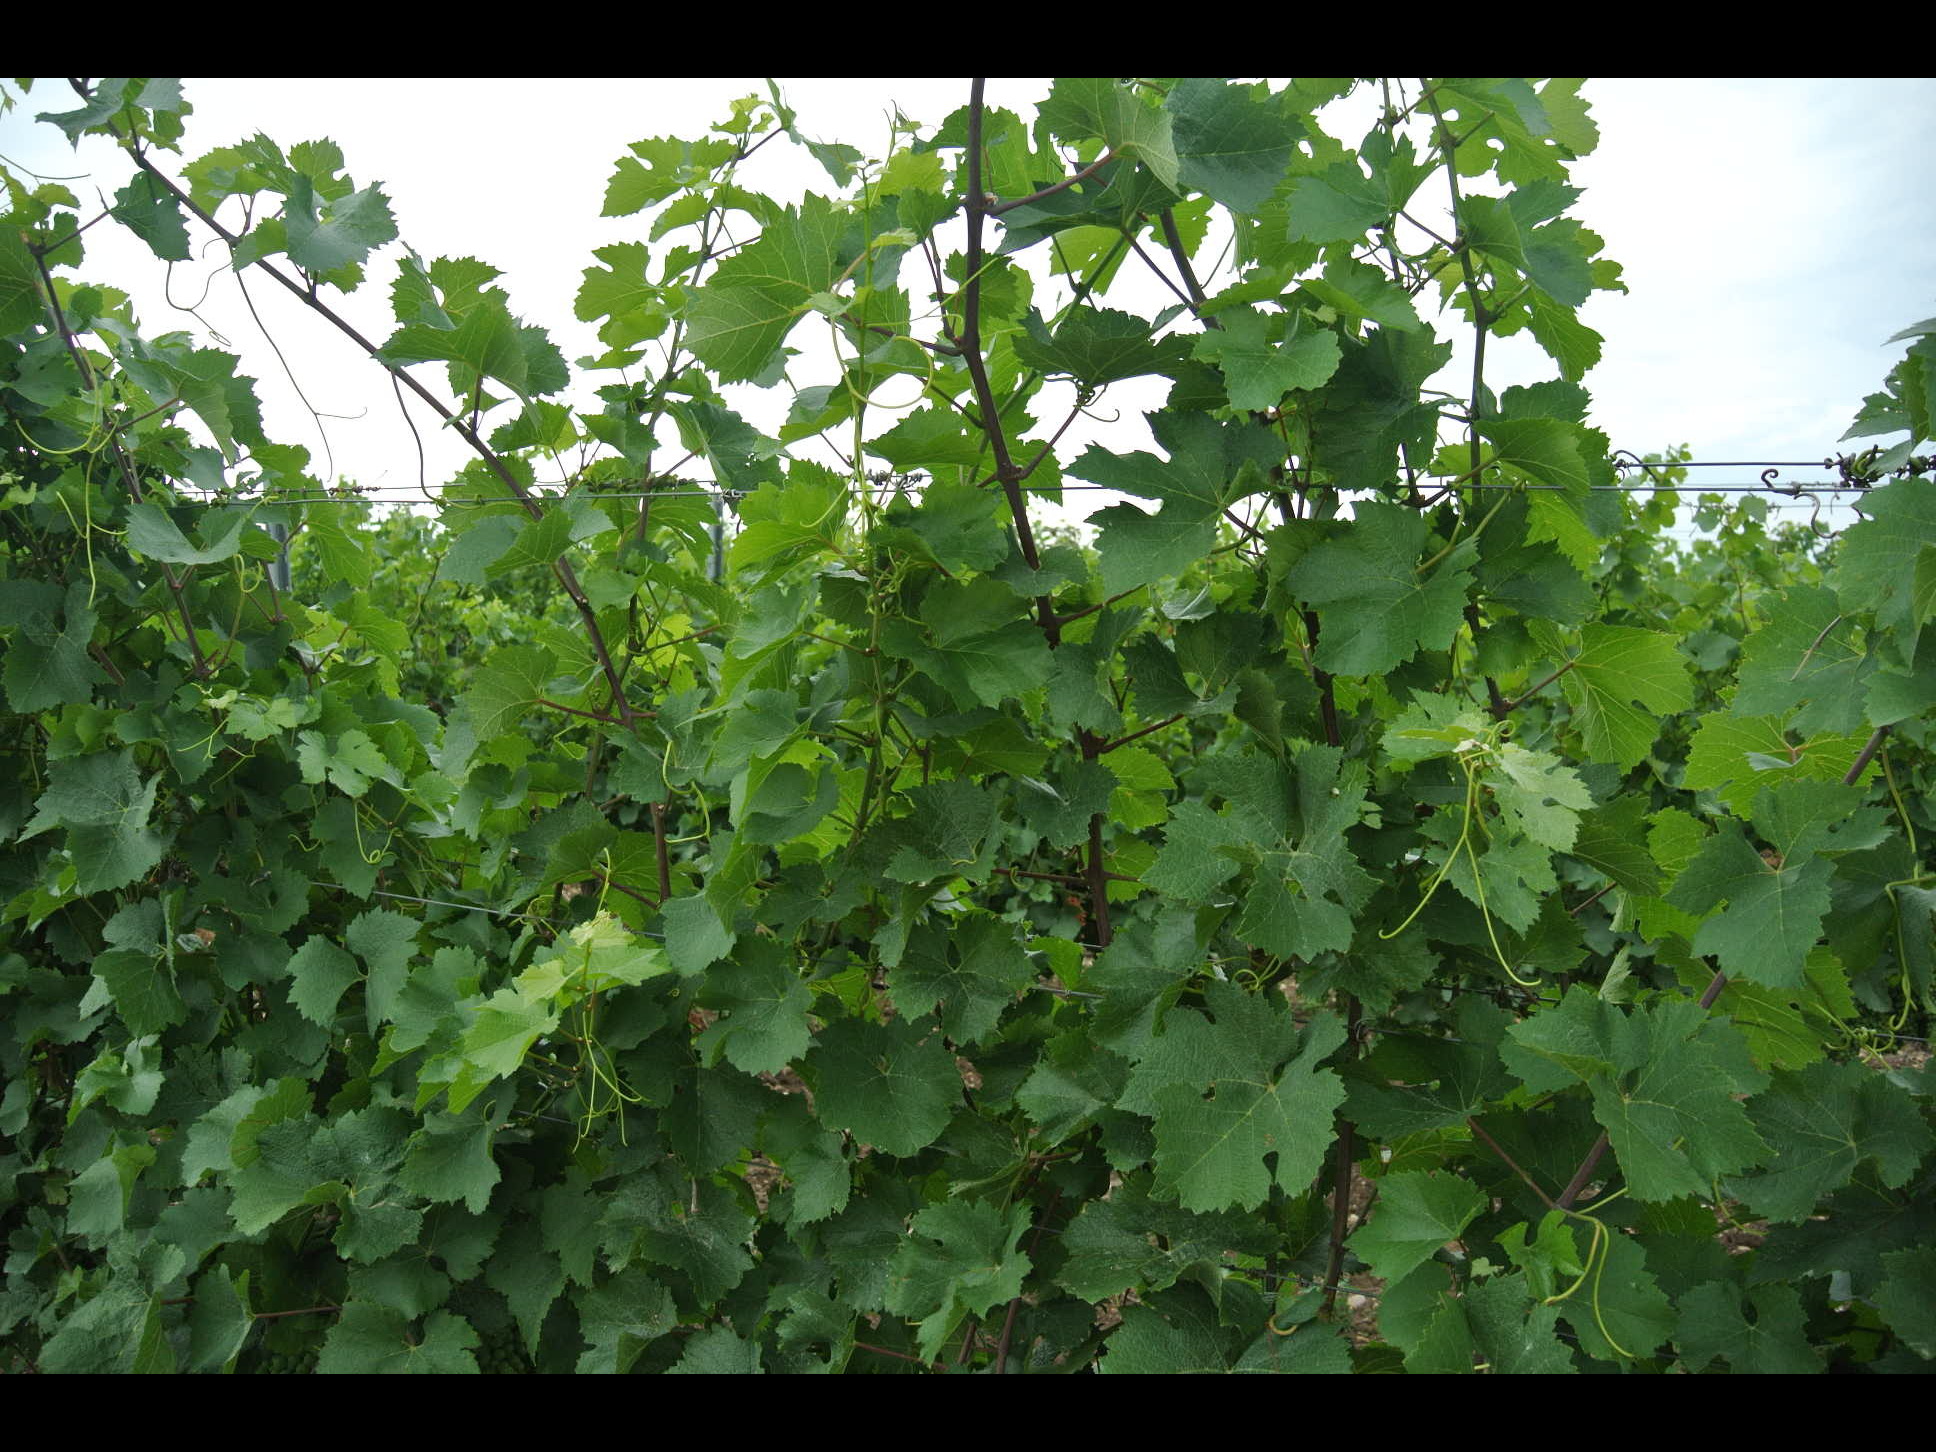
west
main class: Cropland
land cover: Vineyards
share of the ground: 25 - 50 %
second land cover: Other bare soil
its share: > 75 %
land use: Agriculture (excluding fallow land and kitchen gardens)
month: July
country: AT
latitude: 47.8813
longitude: 16.8929
